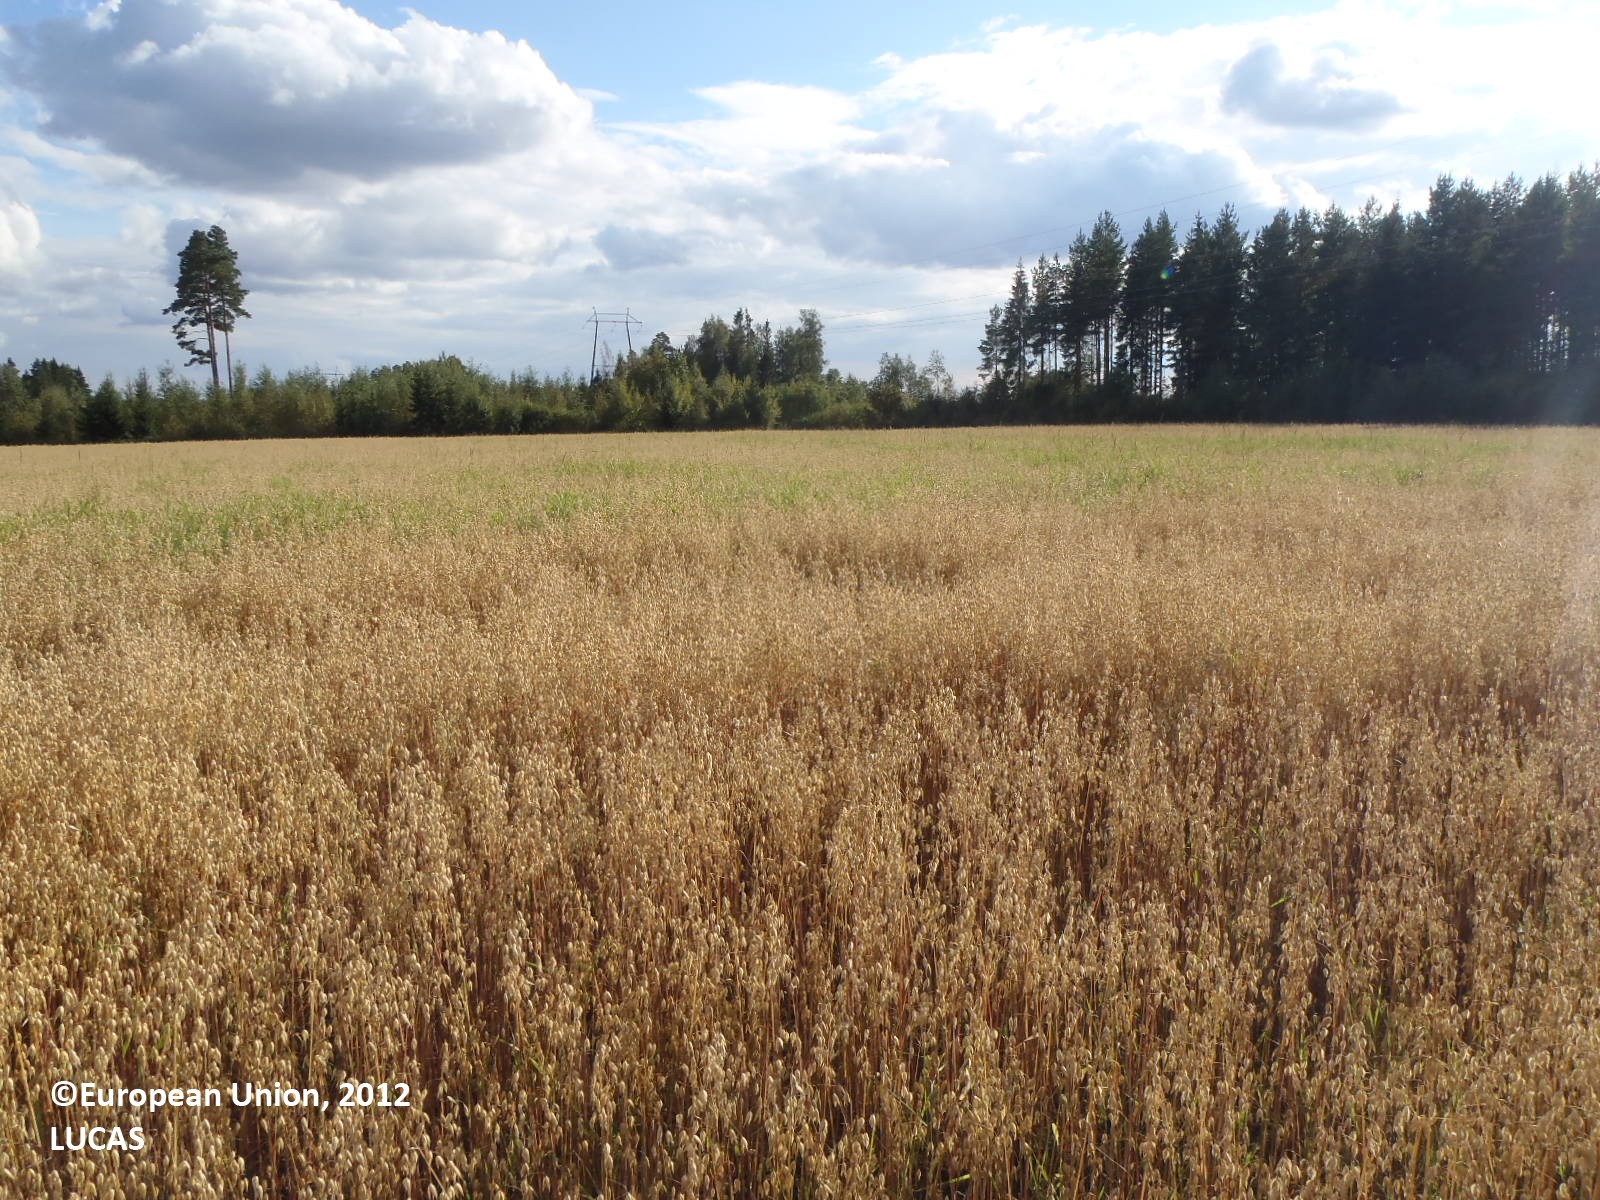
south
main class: Cropland
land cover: Oats
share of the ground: > 75 %
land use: Agriculture (excluding fallow land and kitchen gardens)
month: August
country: FI
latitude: 60.6556
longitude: 22.7874
